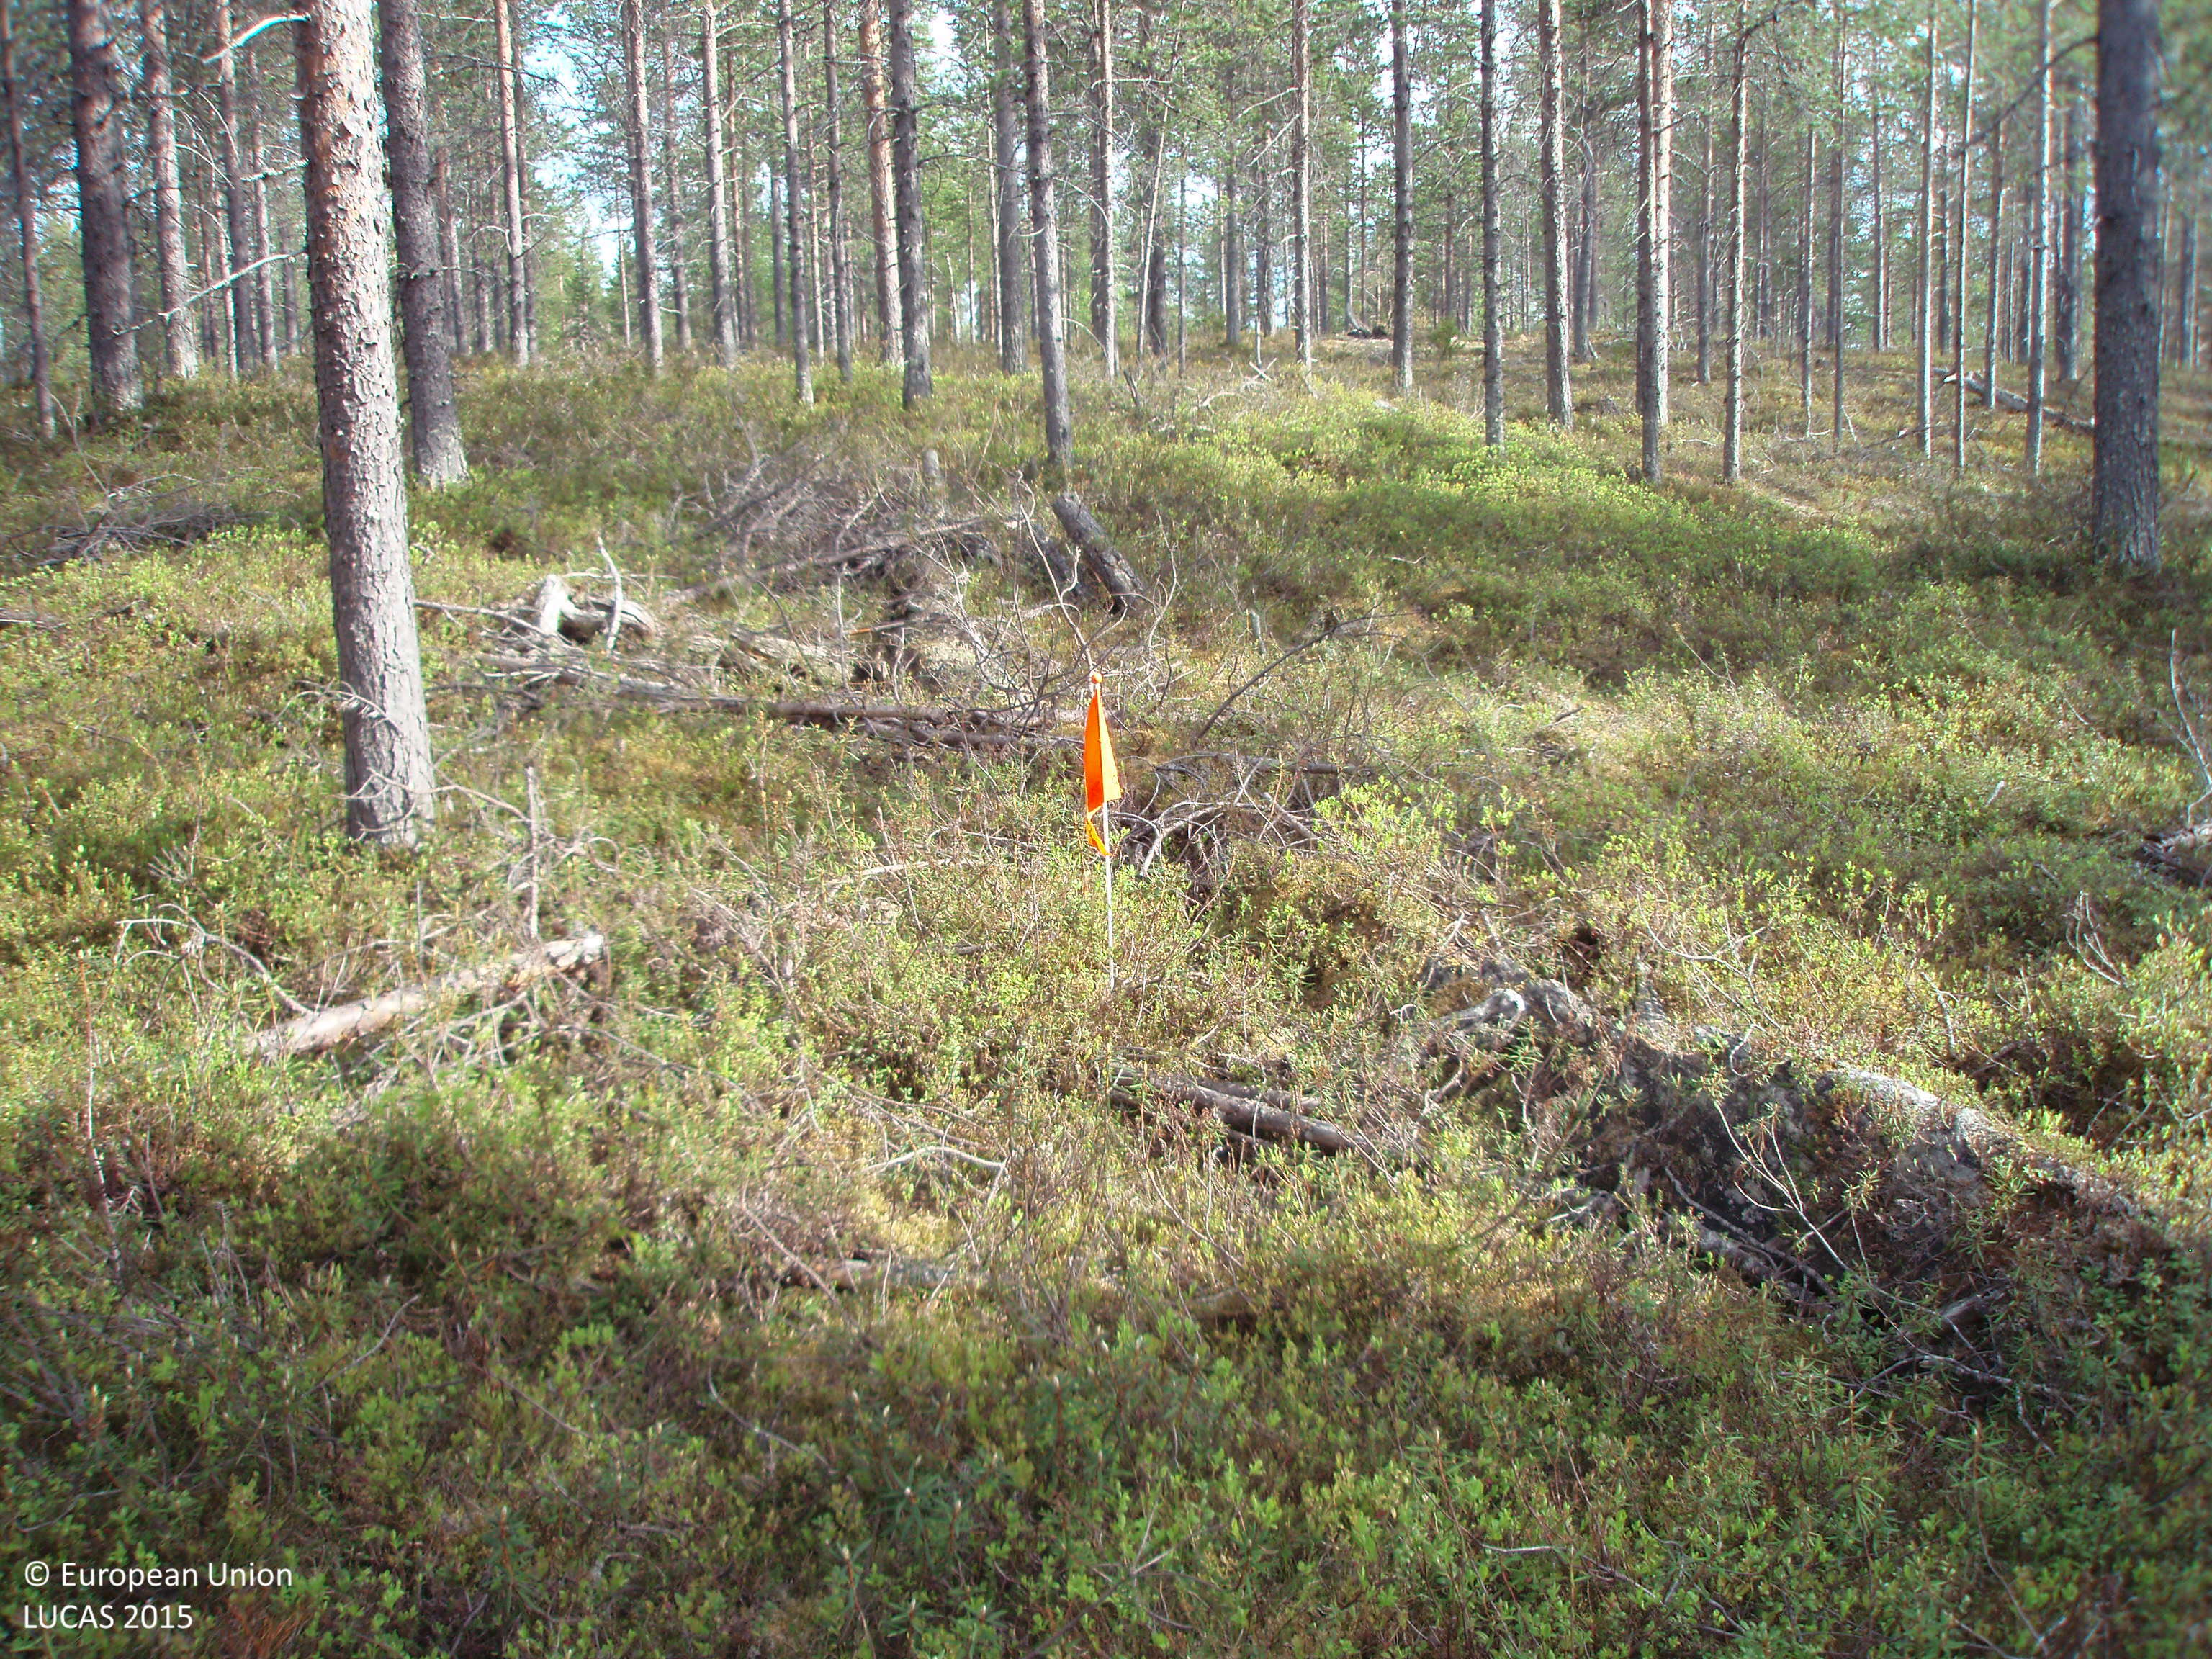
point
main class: Woodland
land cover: Pine dominated coniferous woodland
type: boreal forest
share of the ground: > 75 %
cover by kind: coniferous forest trees 75 %, shrubs 20 %, lichens and mosses 5 %
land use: Forestry
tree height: > 5 m
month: June
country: FI
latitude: 68.7278
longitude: 28.5062
